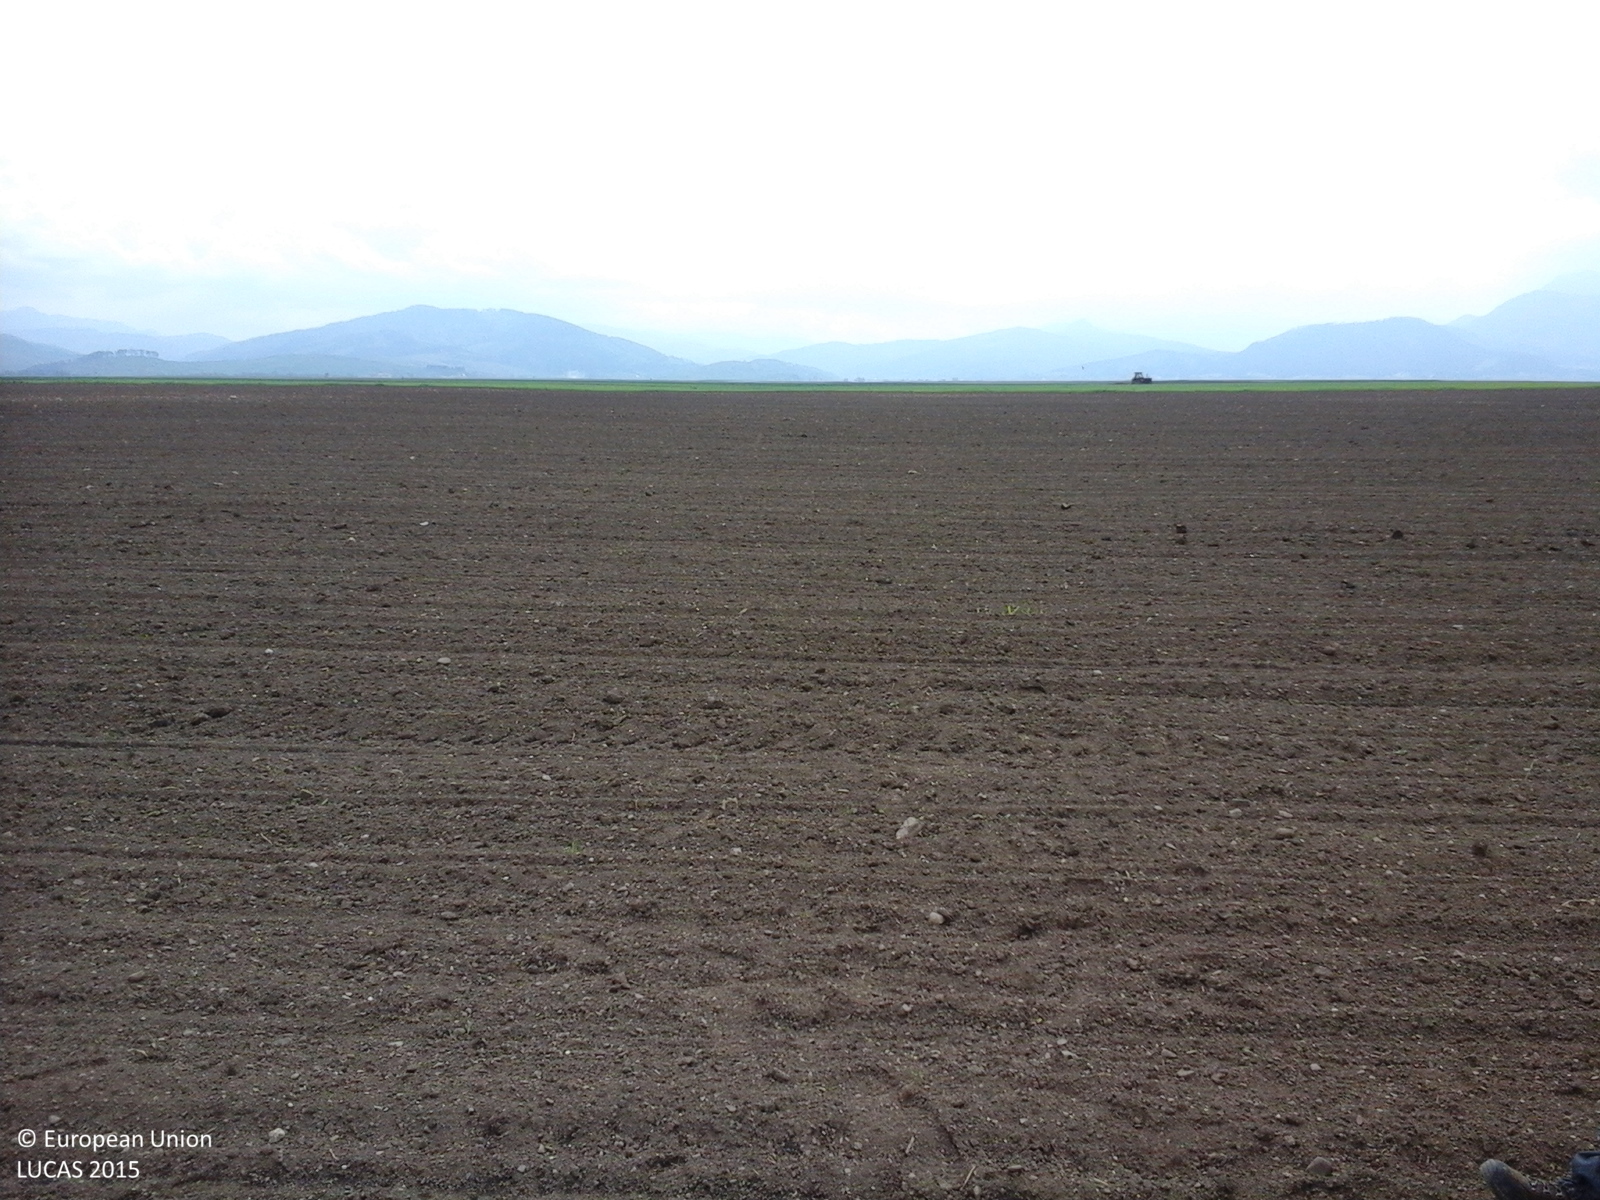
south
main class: Cropland
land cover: Maize
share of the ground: < 10 %
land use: Agriculture (excluding fallow land and kitchen gardens)
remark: Tilled/Sowed
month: May
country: RO
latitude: 45.6907
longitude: 25.7356
